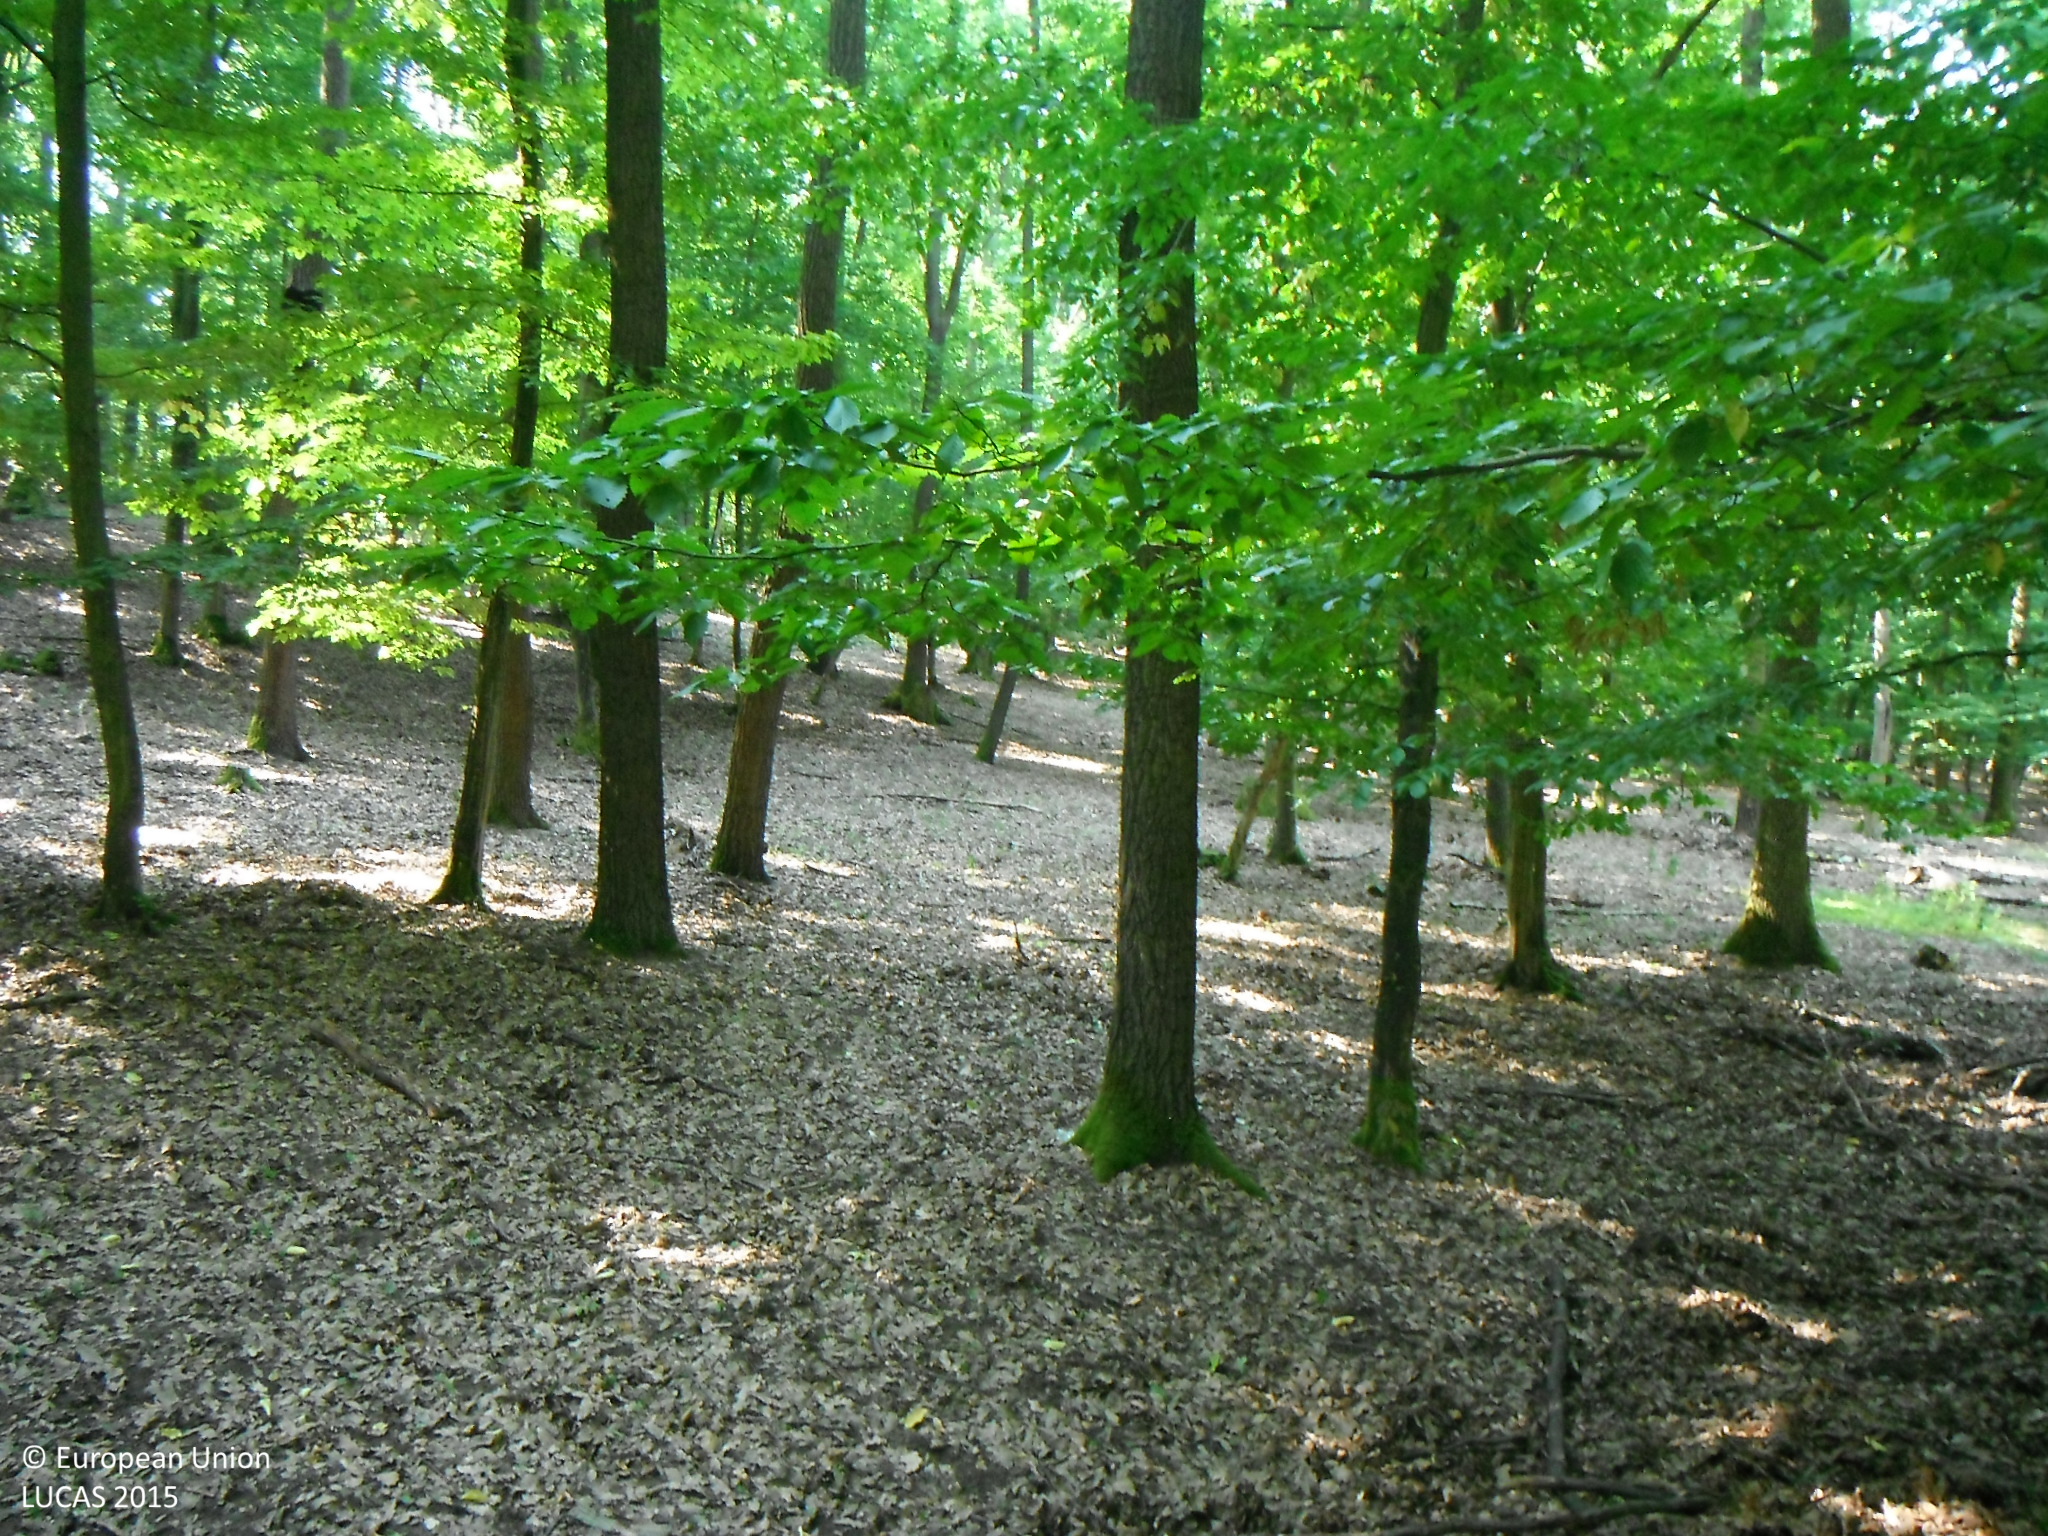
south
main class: Woodland
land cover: Broadleaved woodland
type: acidophilous oak and oak-birch forest
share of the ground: > 75 %
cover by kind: broadleaved forest trees 90 %, unconsolidated bare surface 10 %
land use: Forestry
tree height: > 5 m
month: July
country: SK
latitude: 48.3736
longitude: 20.1150
